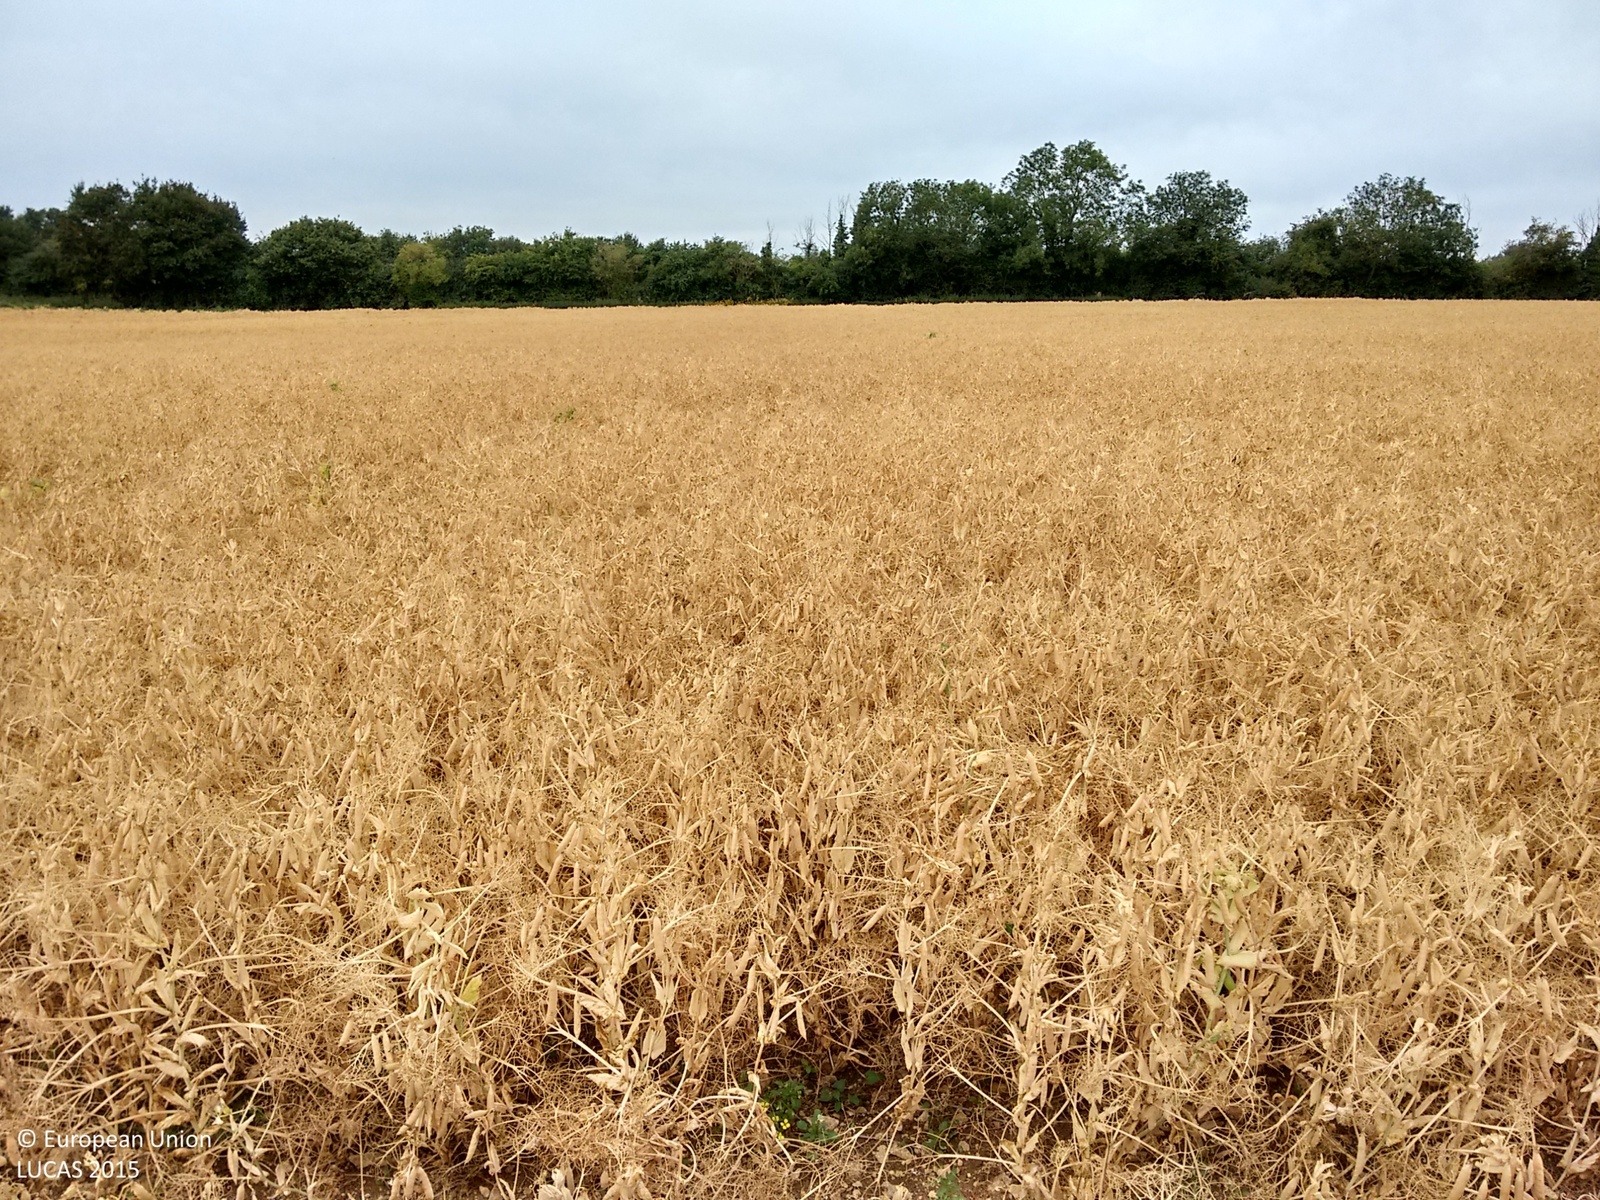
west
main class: Cropland
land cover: Dry pulses
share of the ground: > 75 %
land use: Agriculture (excluding fallow land and kitchen gardens)
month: August
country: GB
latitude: 52.0275
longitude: -1.1967
